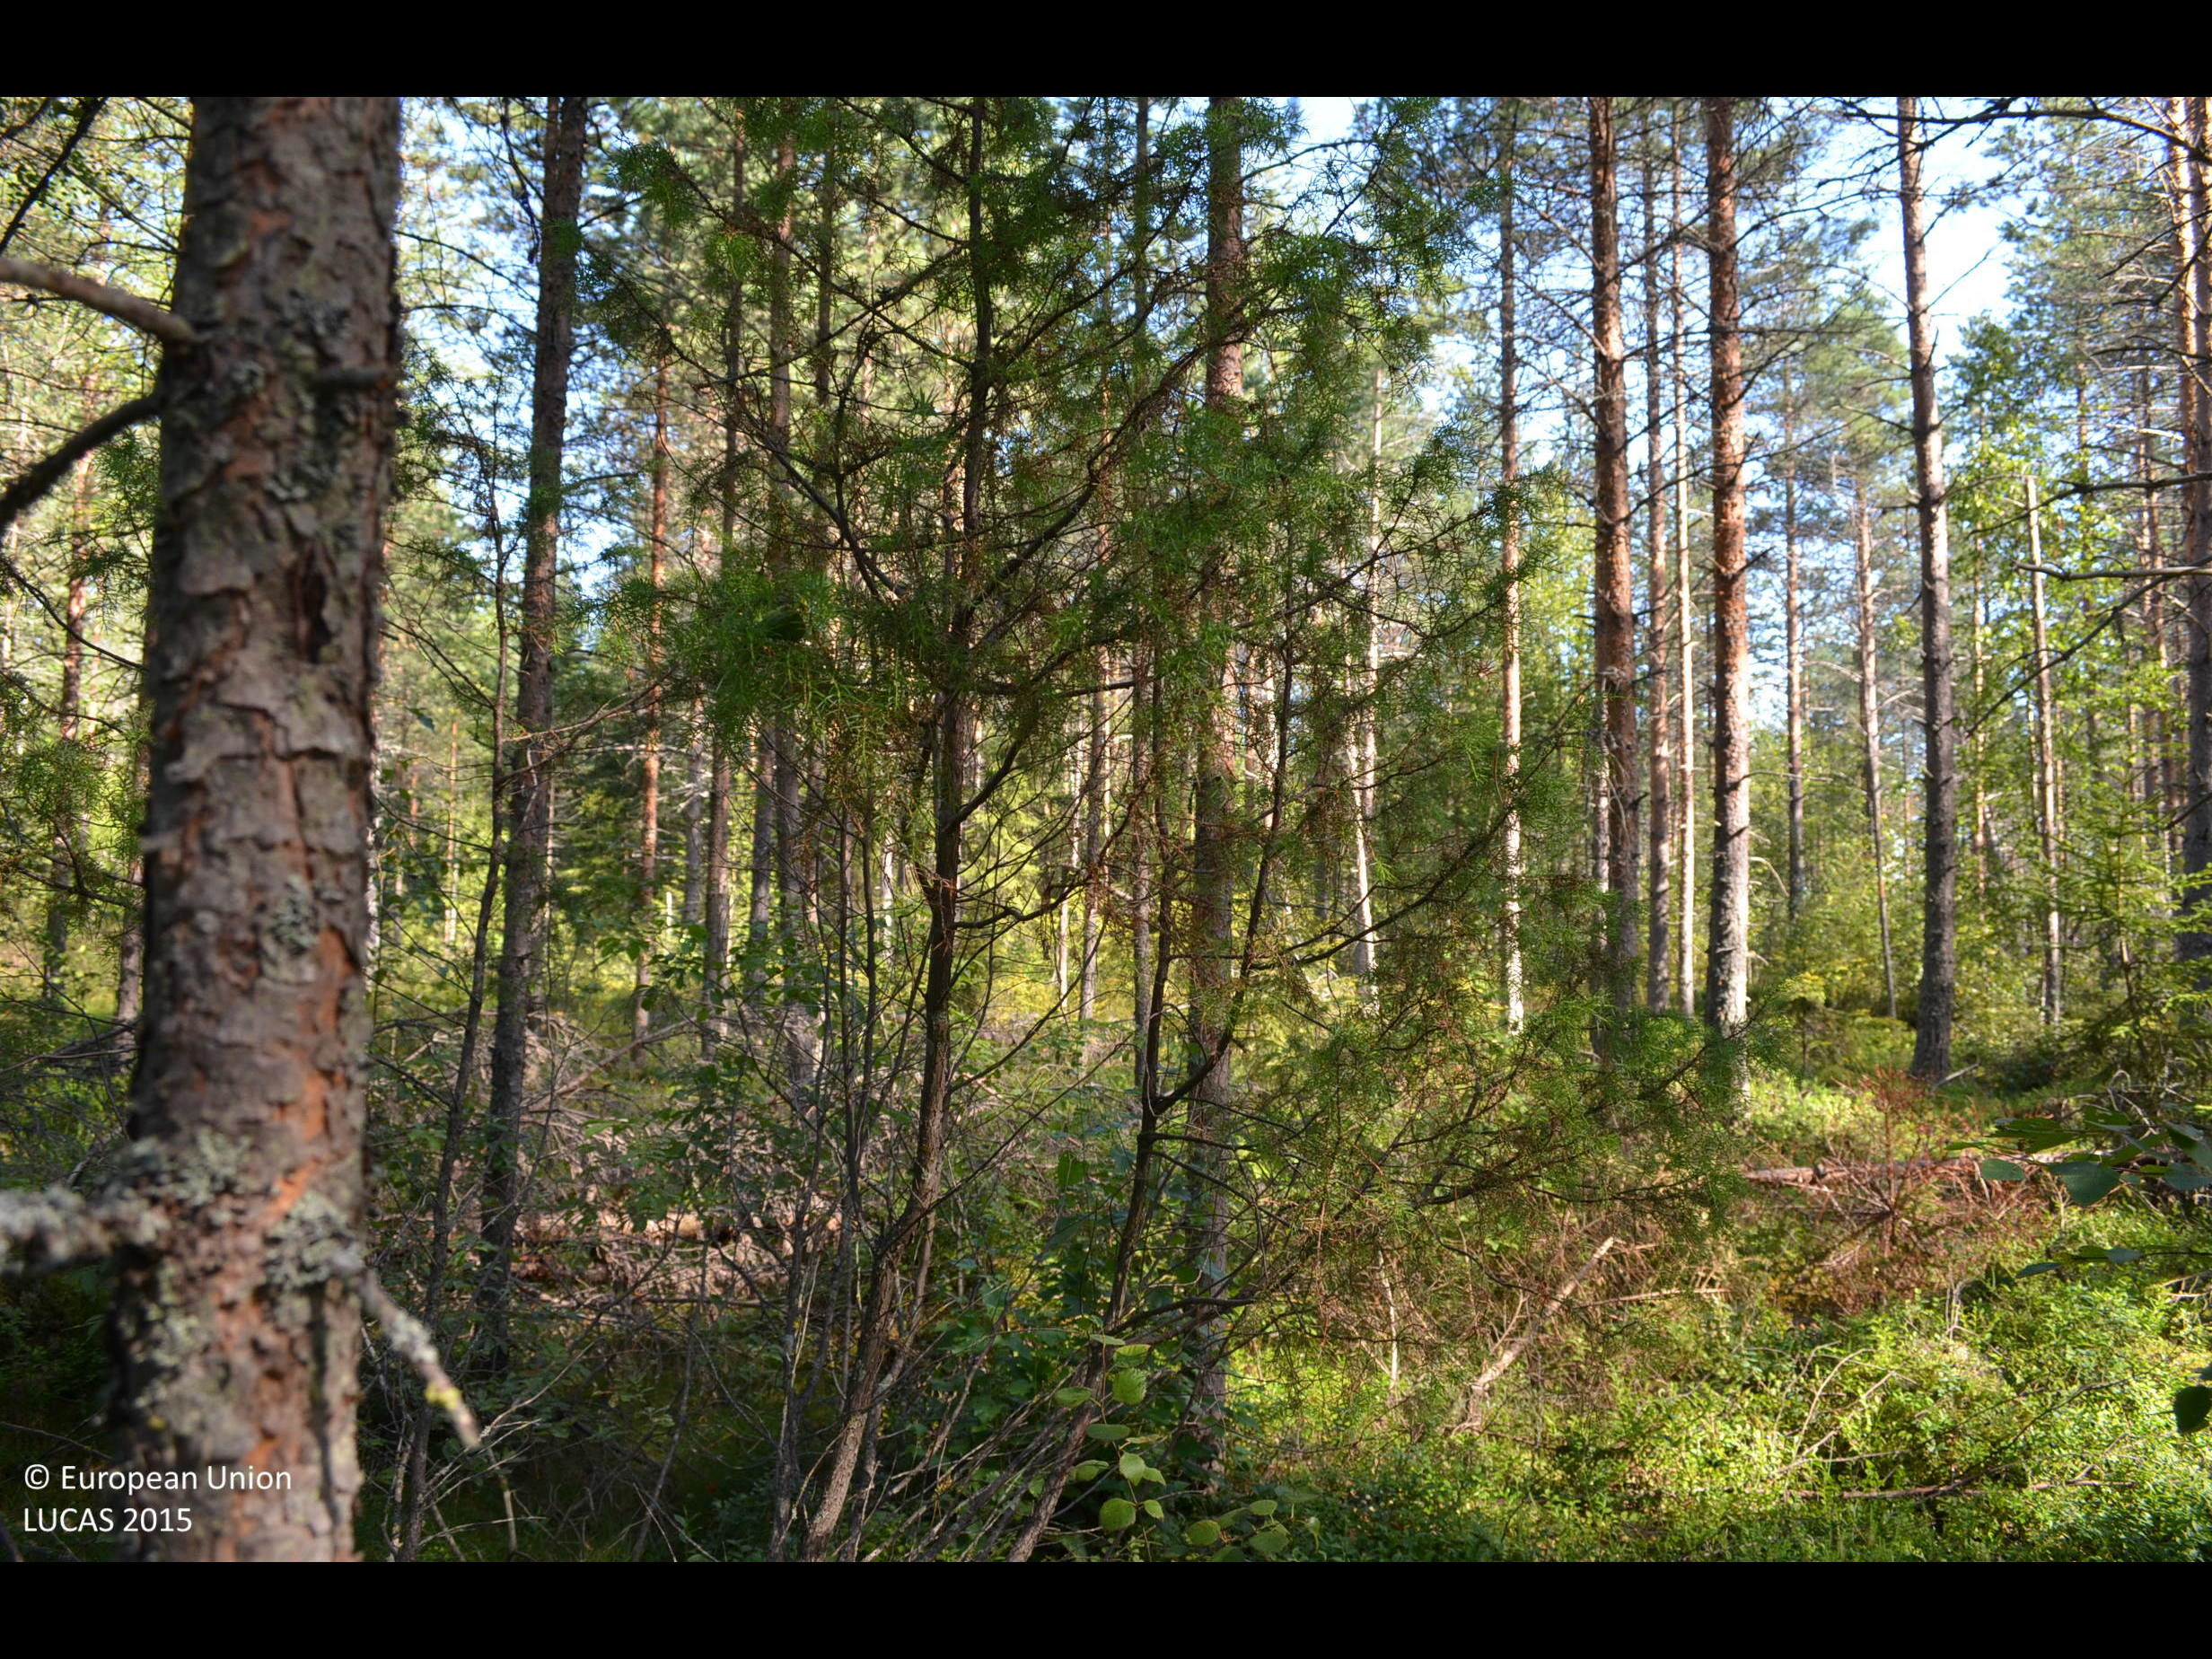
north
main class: Woodland
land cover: Pine dominated mixed woodland
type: boreal forest
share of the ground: > 75 %
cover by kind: coniferous forest trees 50 %, broadleaved forest trees 35 %, shrubs 15 %
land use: Forestry
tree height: > 5 m
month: August
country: FI
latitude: 62.2504
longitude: 24.3547
